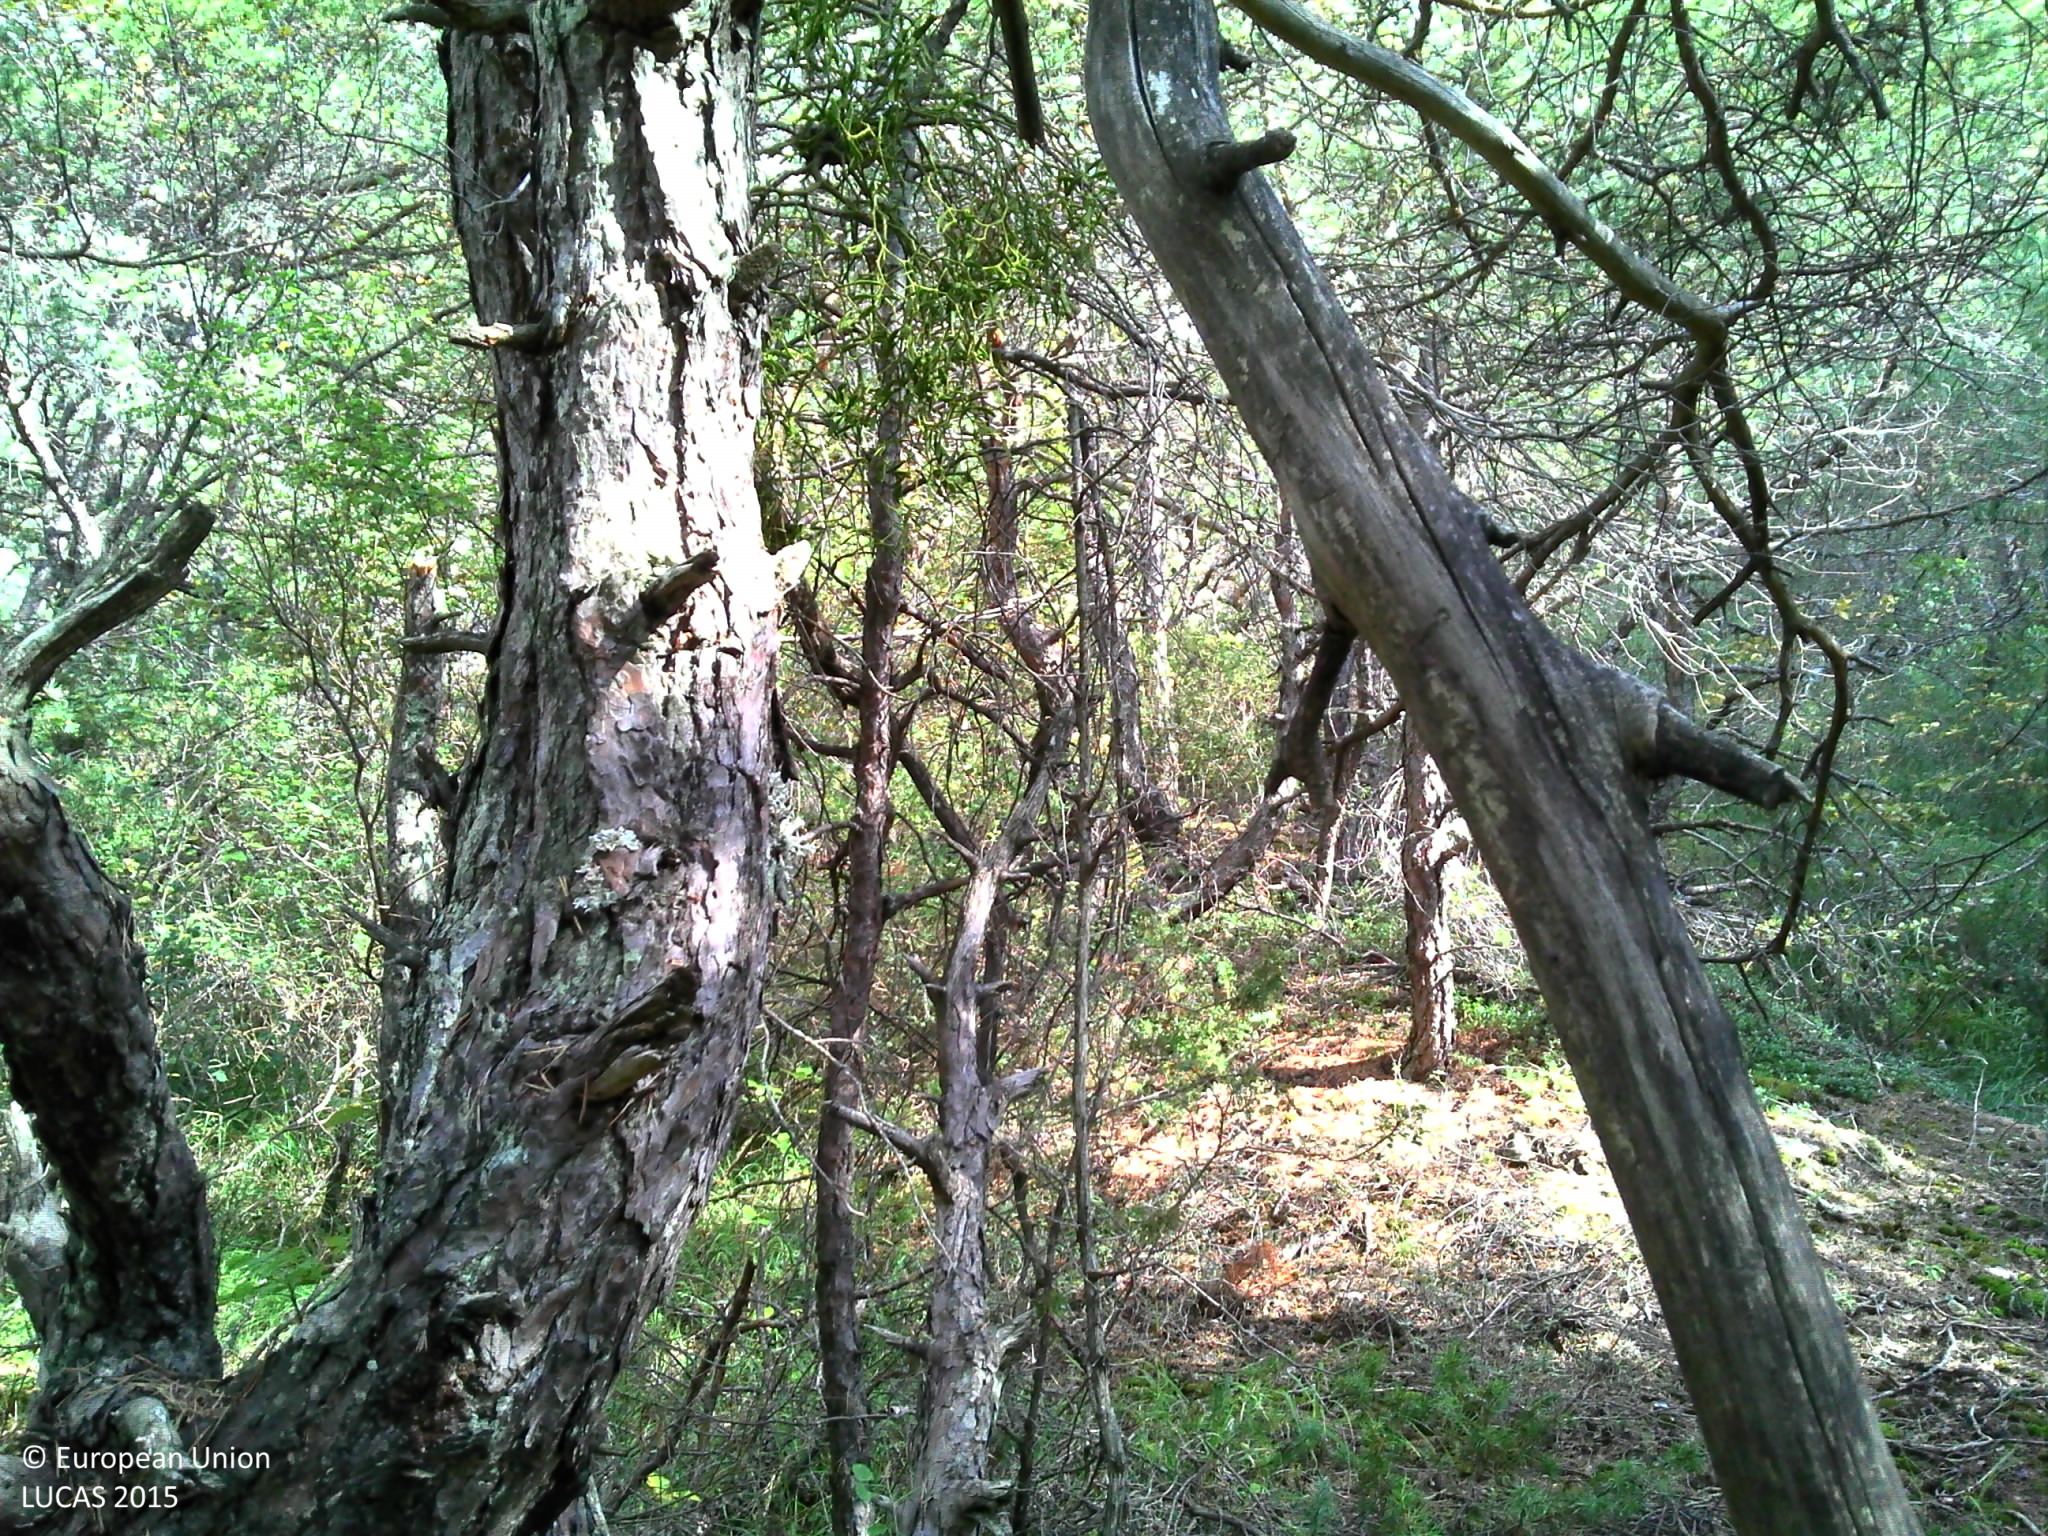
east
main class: Woodland
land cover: Pine dominated coniferous woodland
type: hemiboreal forest and nemoral coniferous forest and mixed broadleaved-coniferous forest
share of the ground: > 75 %
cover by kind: coniferous forest trees 70 %, broadleaved forest trees 10 %, shrubs 10 %, herbaceous plants 5 %, consolidated bare surface 5 %
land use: Forestry
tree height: > 5 m
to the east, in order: Pine dominated coniferous woodland; Tracks; Pine dominated coniferous woodland; Shrubland without tree cover; Pine dominated coniferous woodland; Pine dominated mixed woodland; Pine dominated coniferous woodland
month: September
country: FR
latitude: 44.5344
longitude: 6.2187
